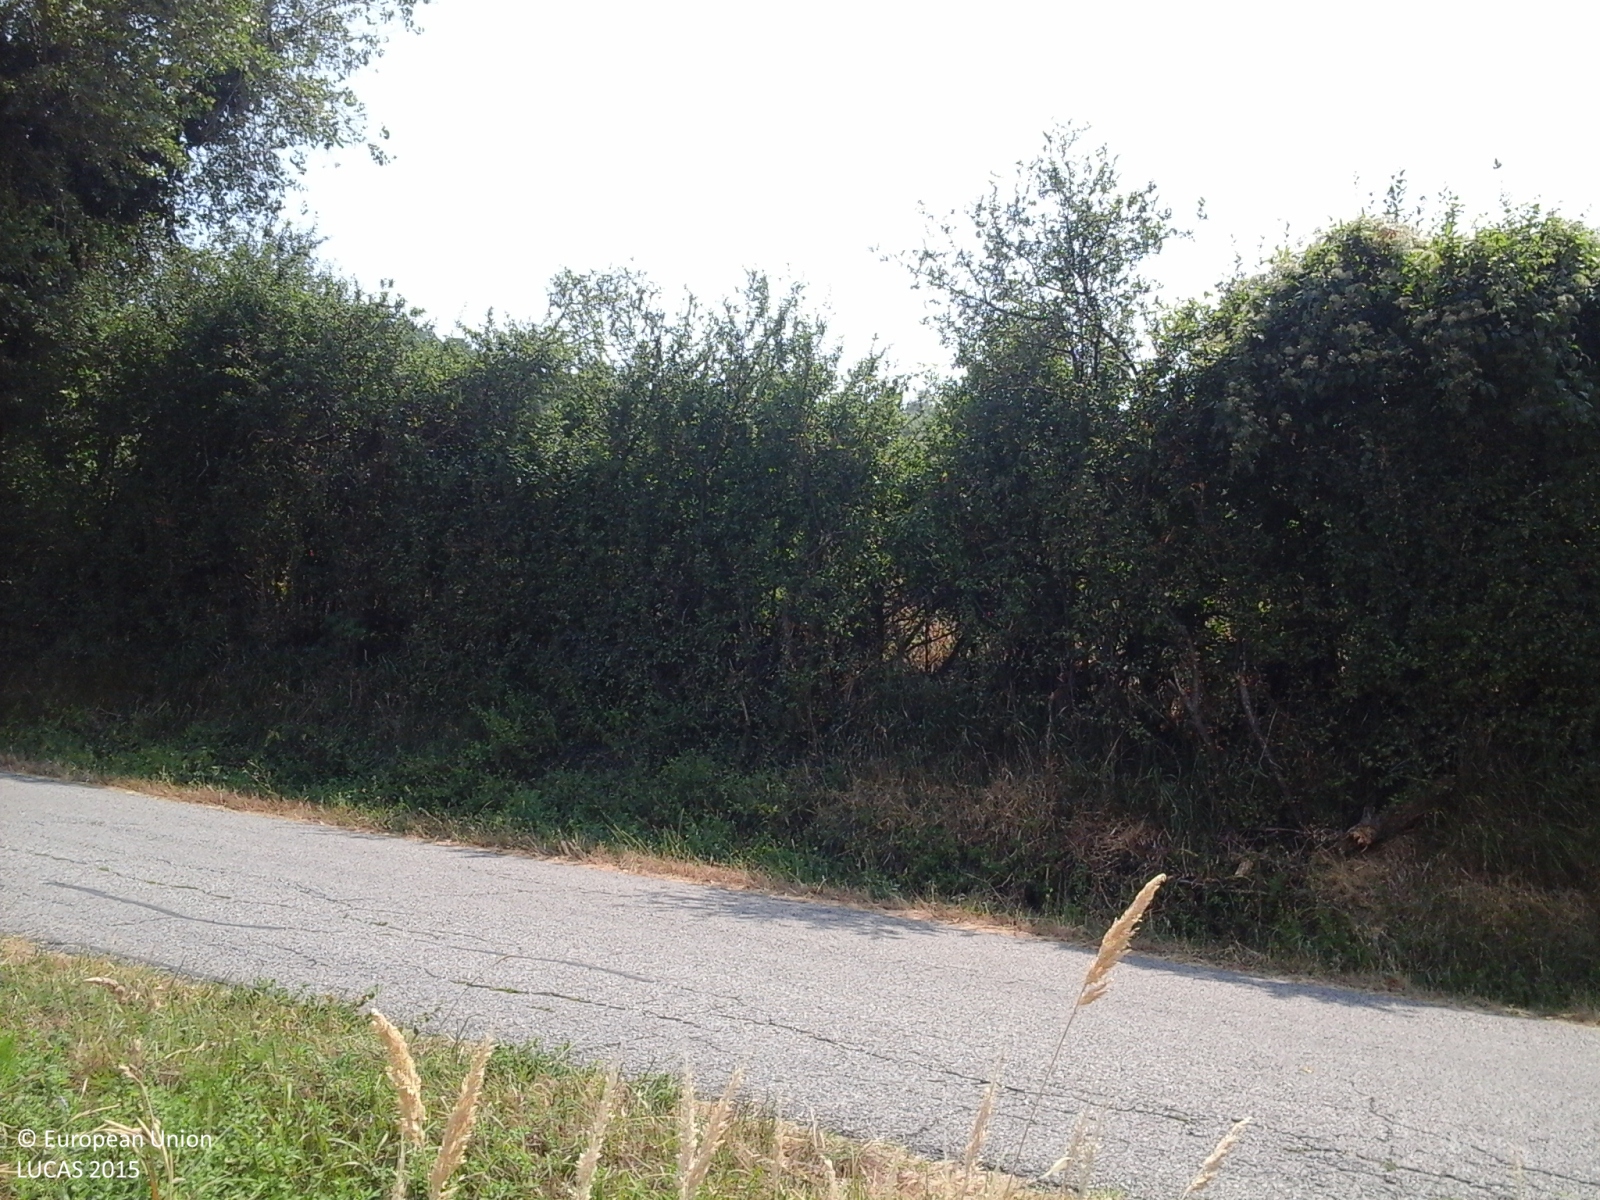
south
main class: Cropland
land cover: Other leguminous and mixtures for fodder
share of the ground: > 75 %
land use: Agriculture (excluding fallow land and kitchen gardens)
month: July
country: IT
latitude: 44.0352
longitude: 12.3529
